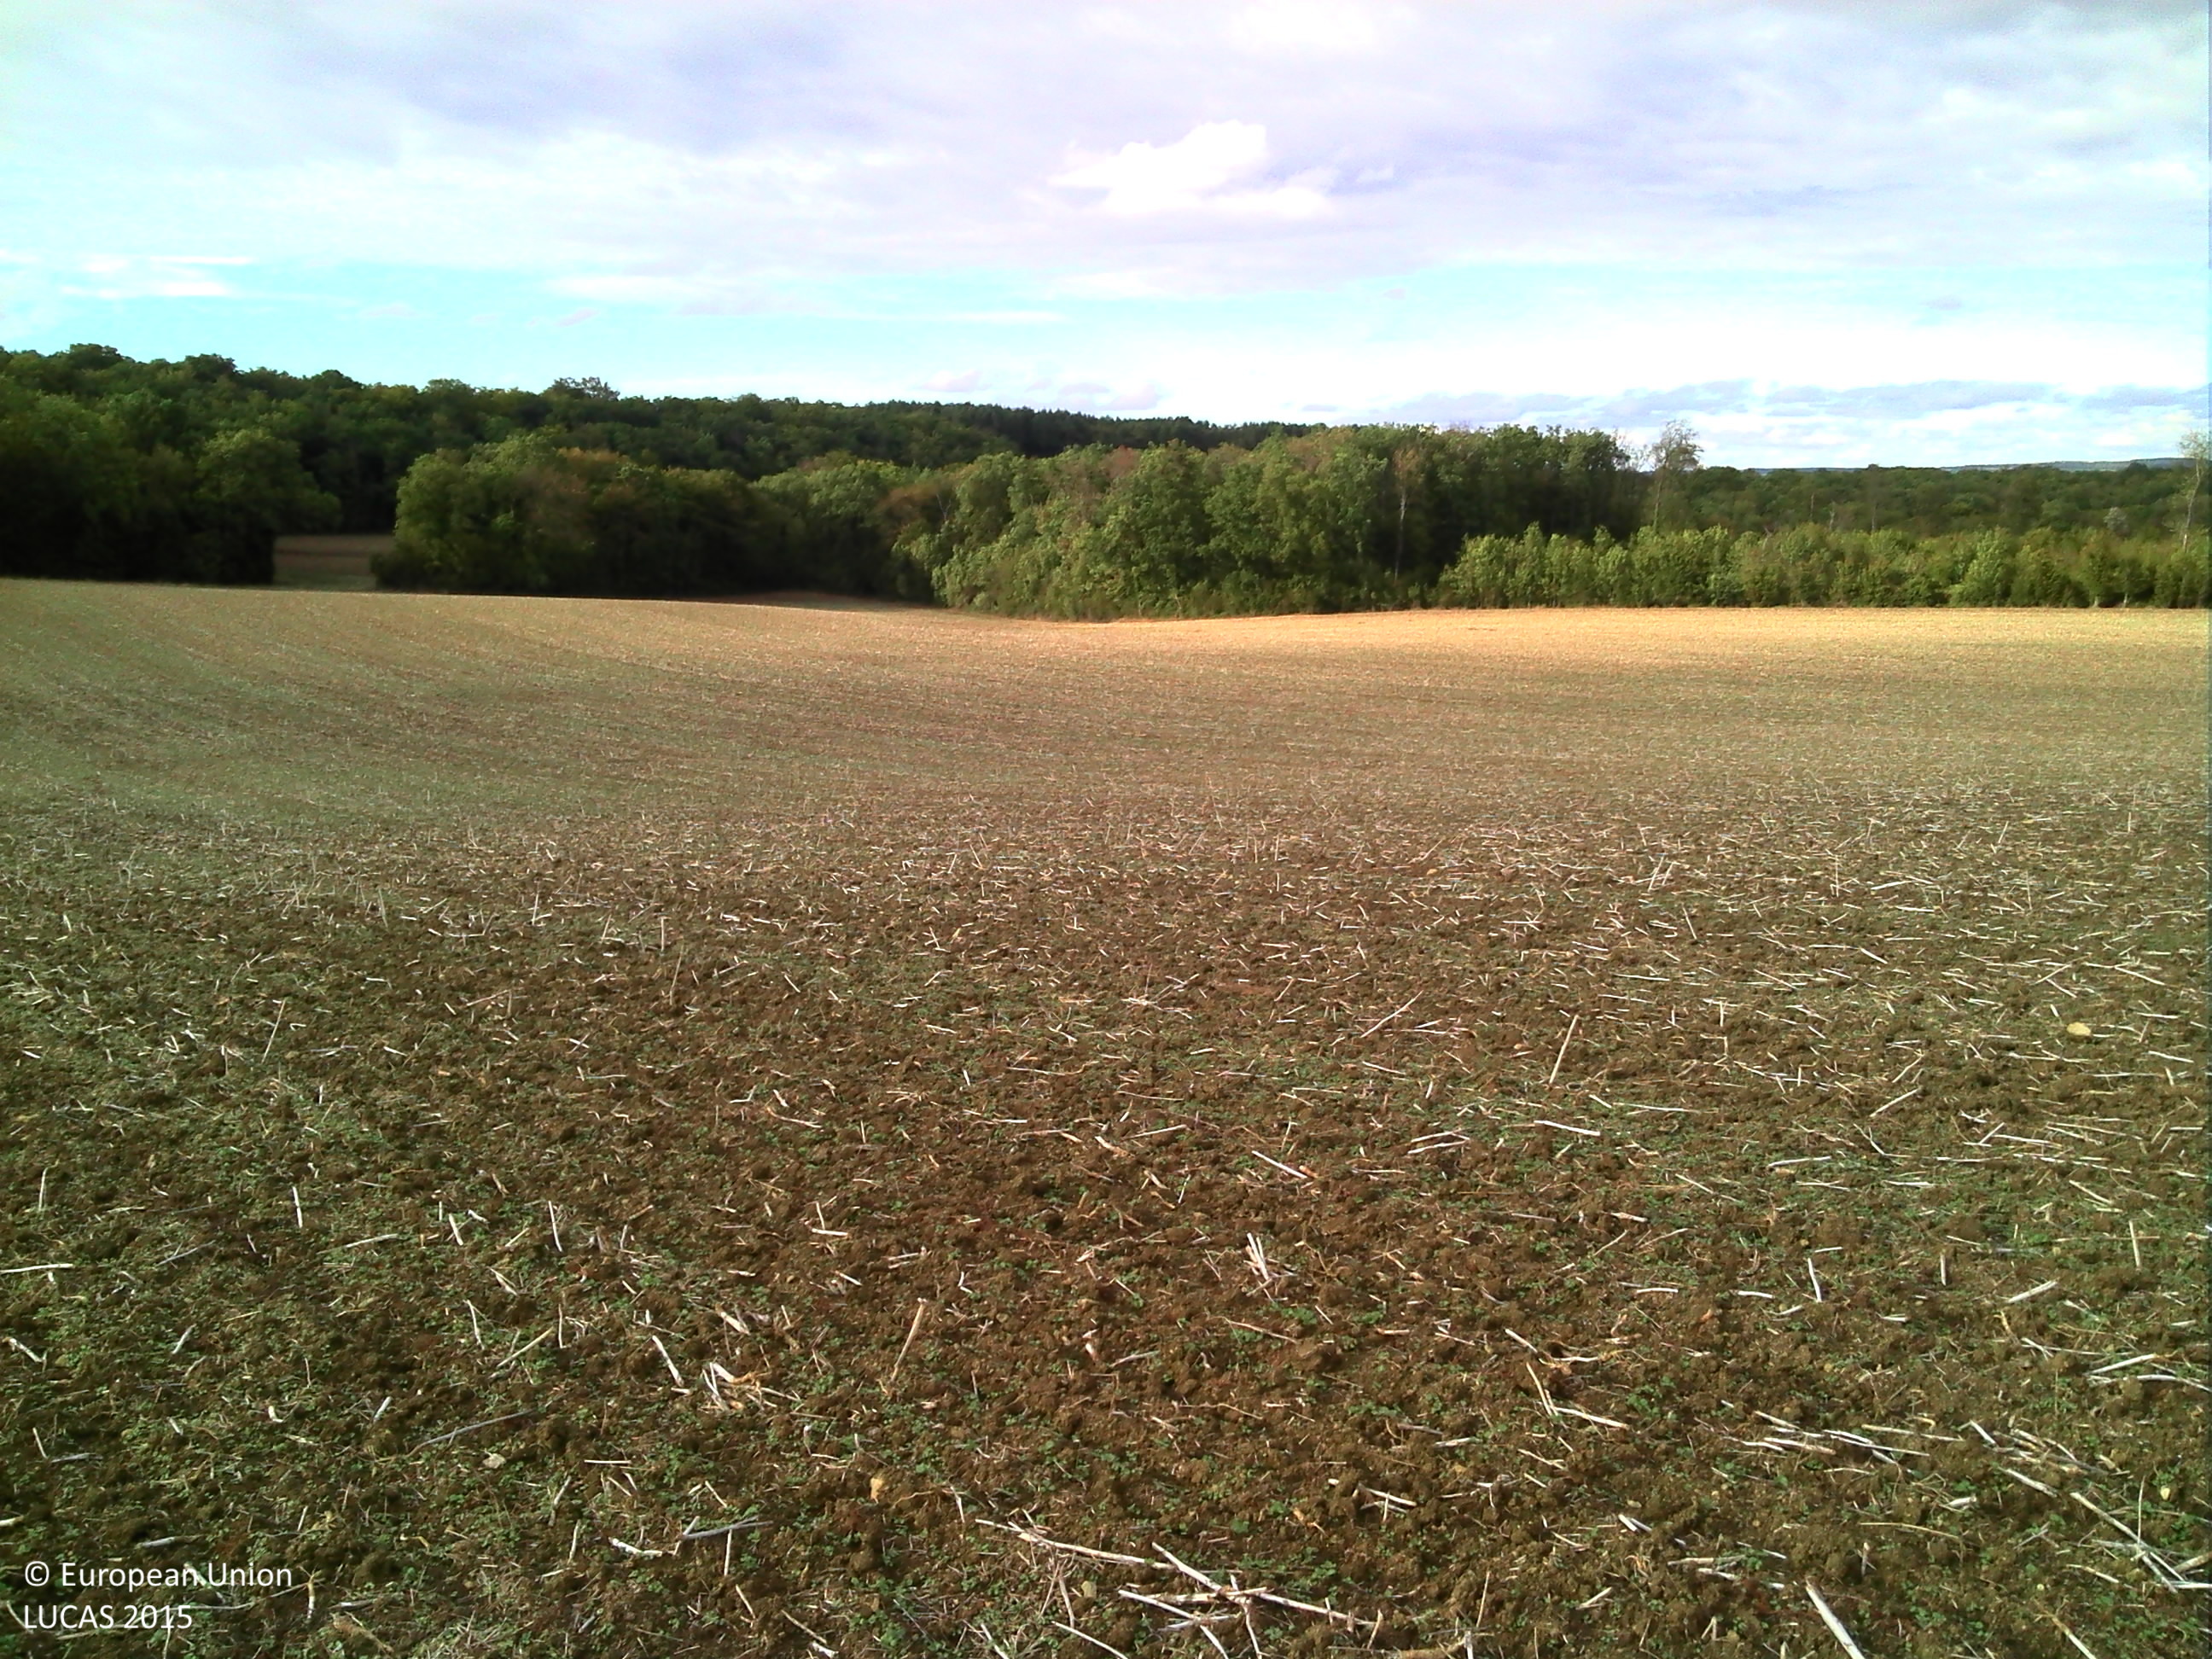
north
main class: Cropland
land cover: Rape and turnip rape
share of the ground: < 10 %
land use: Agriculture (excluding fallow land and kitchen gardens)
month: September
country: FR
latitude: 48.1702
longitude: 4.7406
